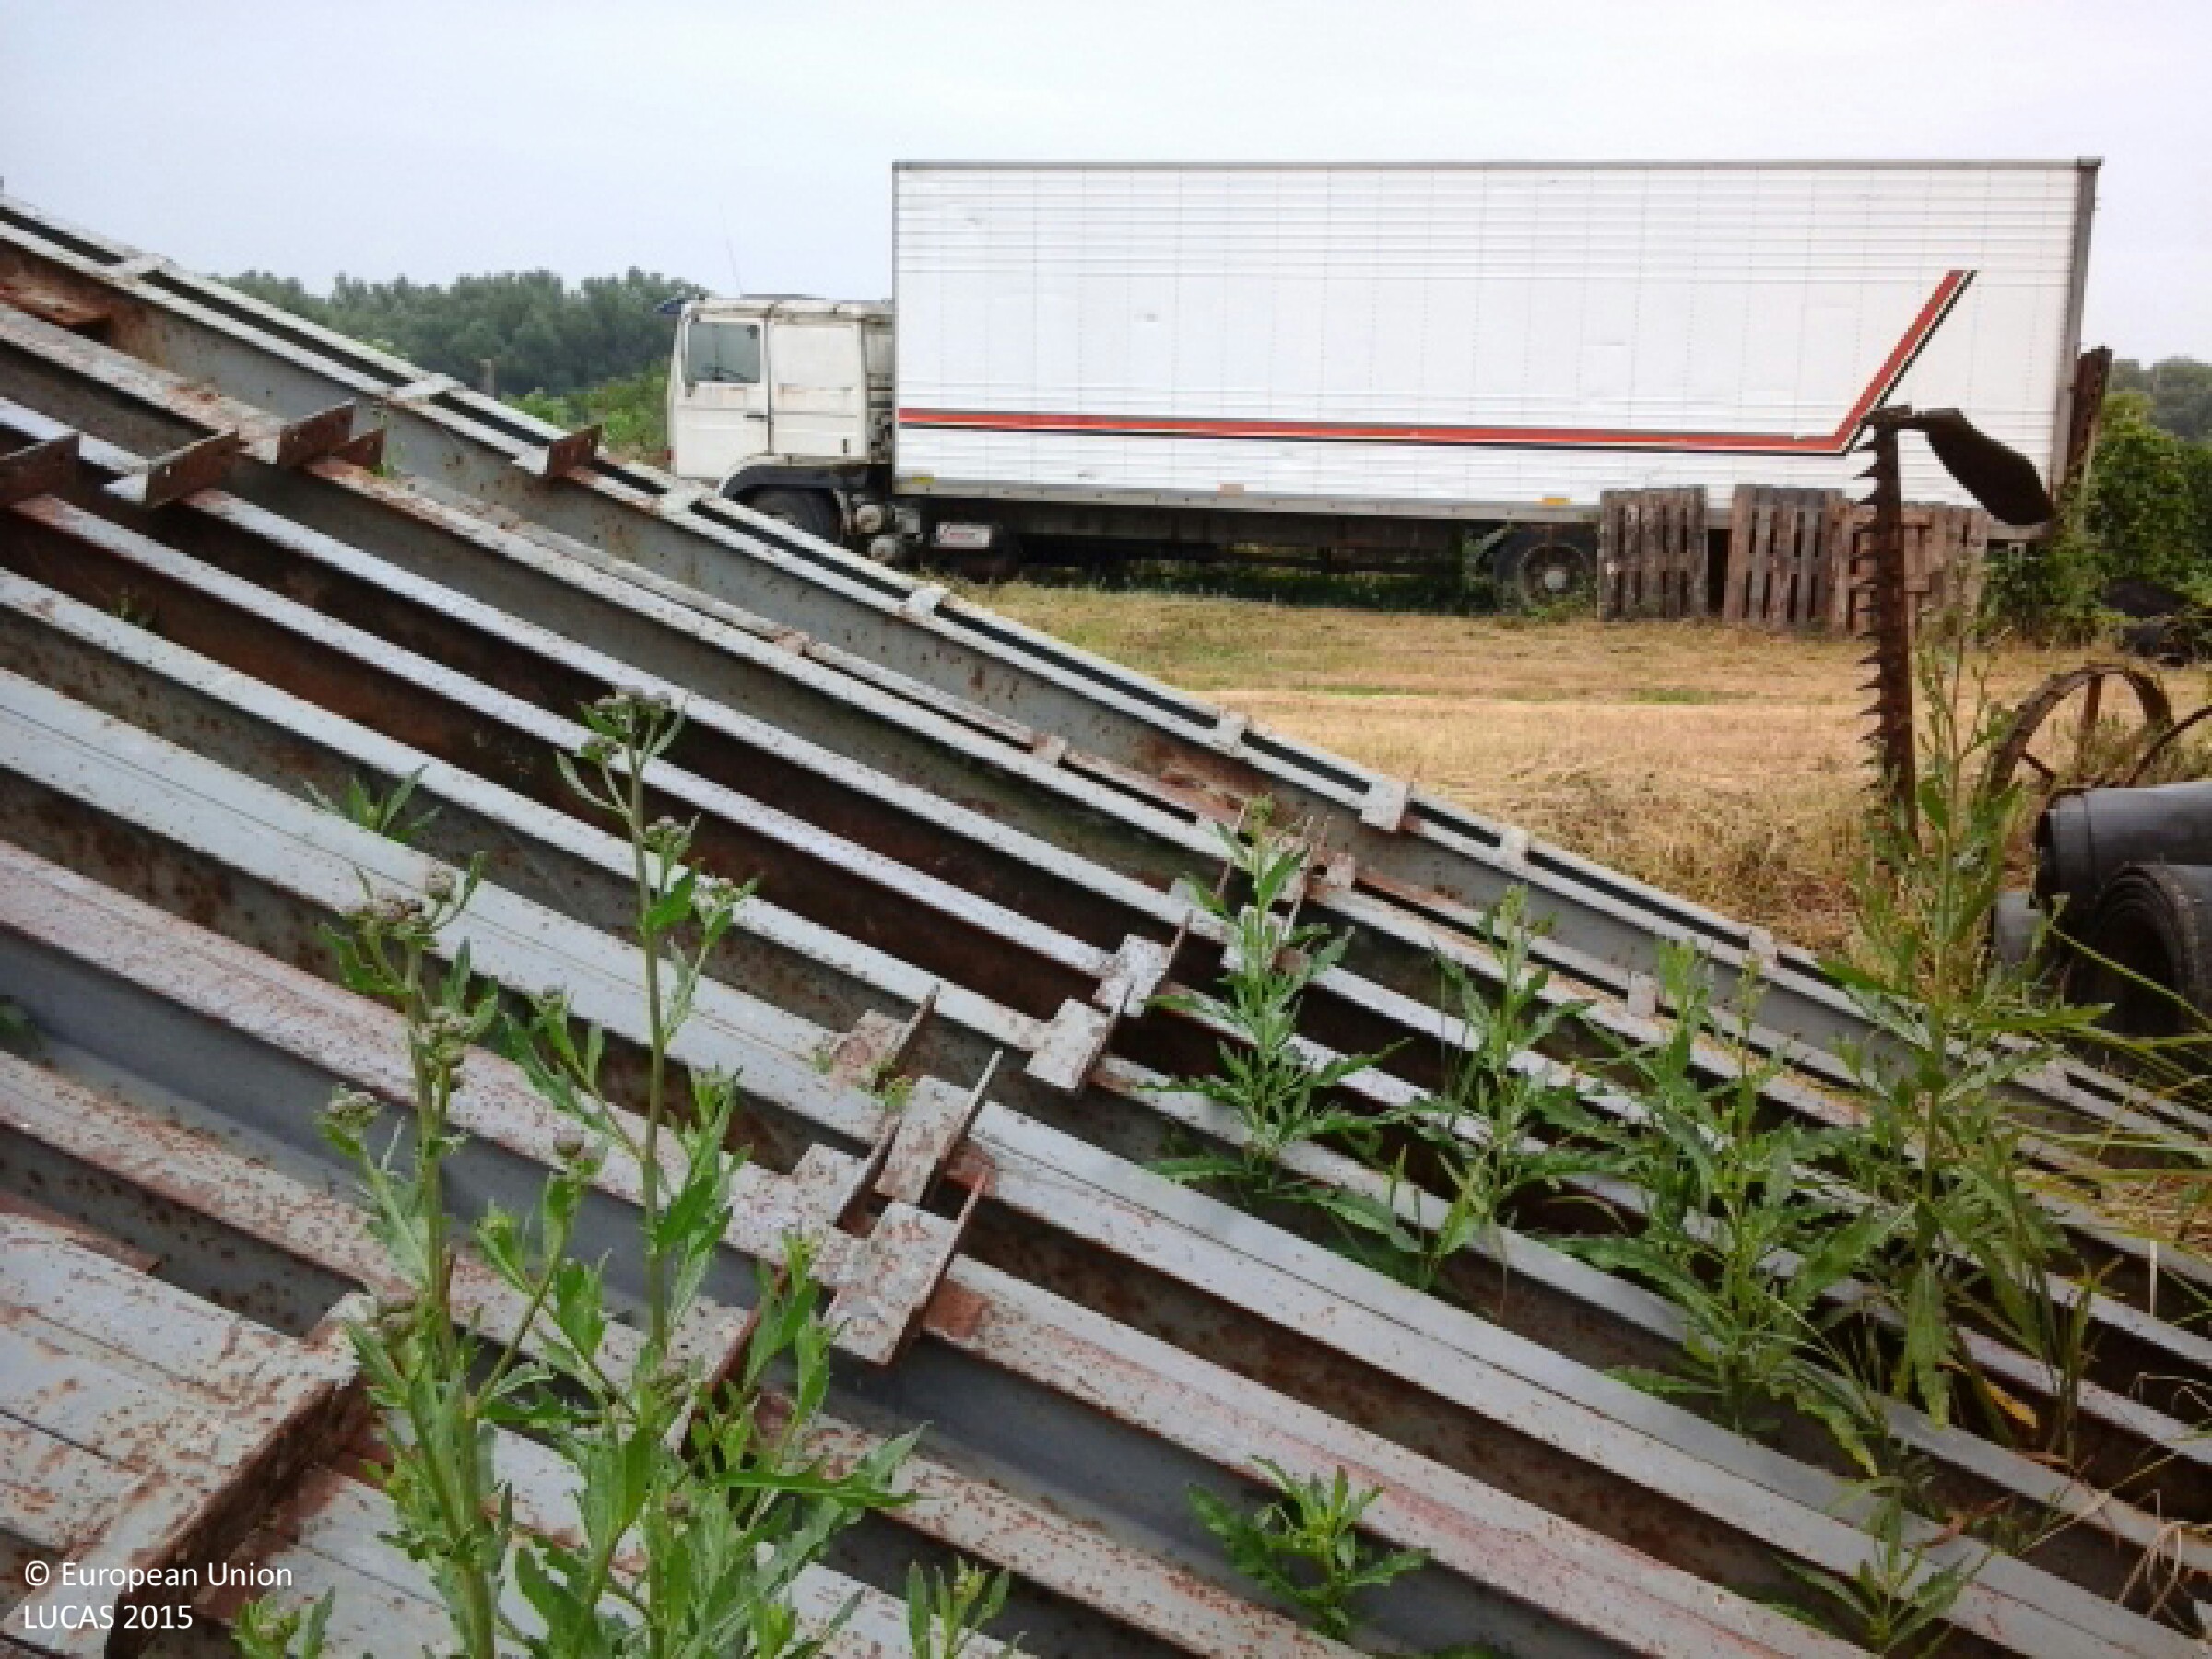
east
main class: Grassland
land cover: Spontaneously vegetated surfaces
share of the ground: > 75 %
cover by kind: herbaceous plants 90 %, unconsolidated bare surface 10 %
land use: Abandoned areas
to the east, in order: Spontaneously vegetated surfaces; Fences; Grass margins; Tracks; Grass margins; Fences; Grass margins; Maize; Fences; Grassland without tree/shrub cover
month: June
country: HU
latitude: 47.9753
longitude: 21.7432
